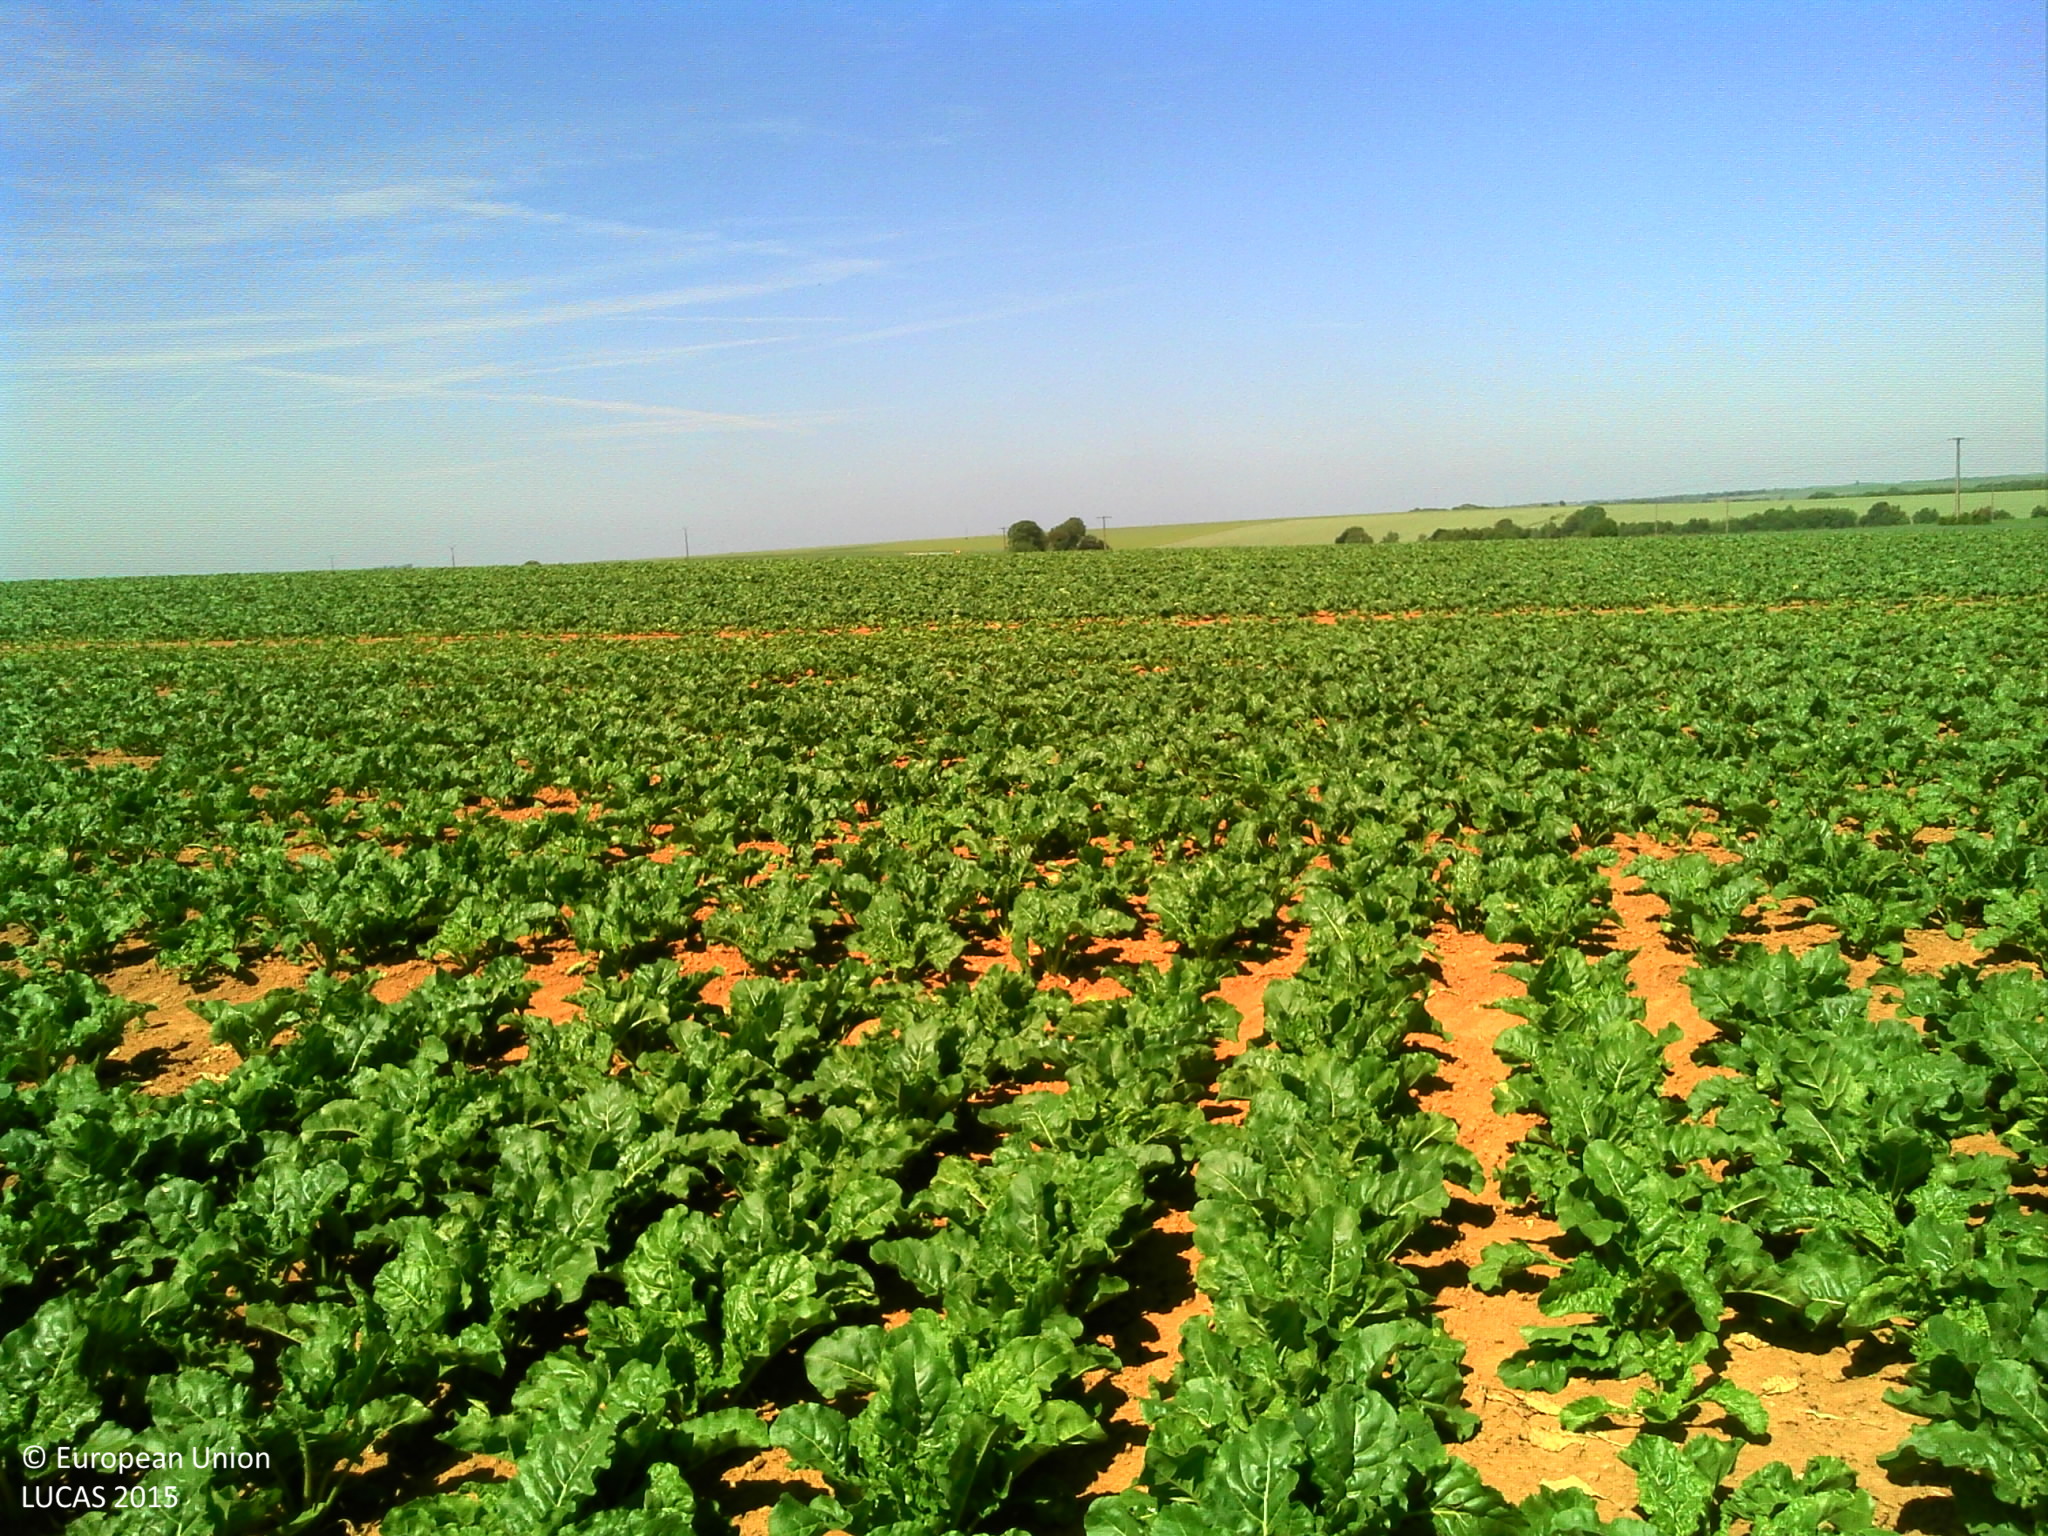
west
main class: Cropland
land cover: Sugar beet
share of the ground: > 75 %
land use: Agriculture (excluding fallow land and kitchen gardens)
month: June
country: FR
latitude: 49.4442
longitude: 3.2751
